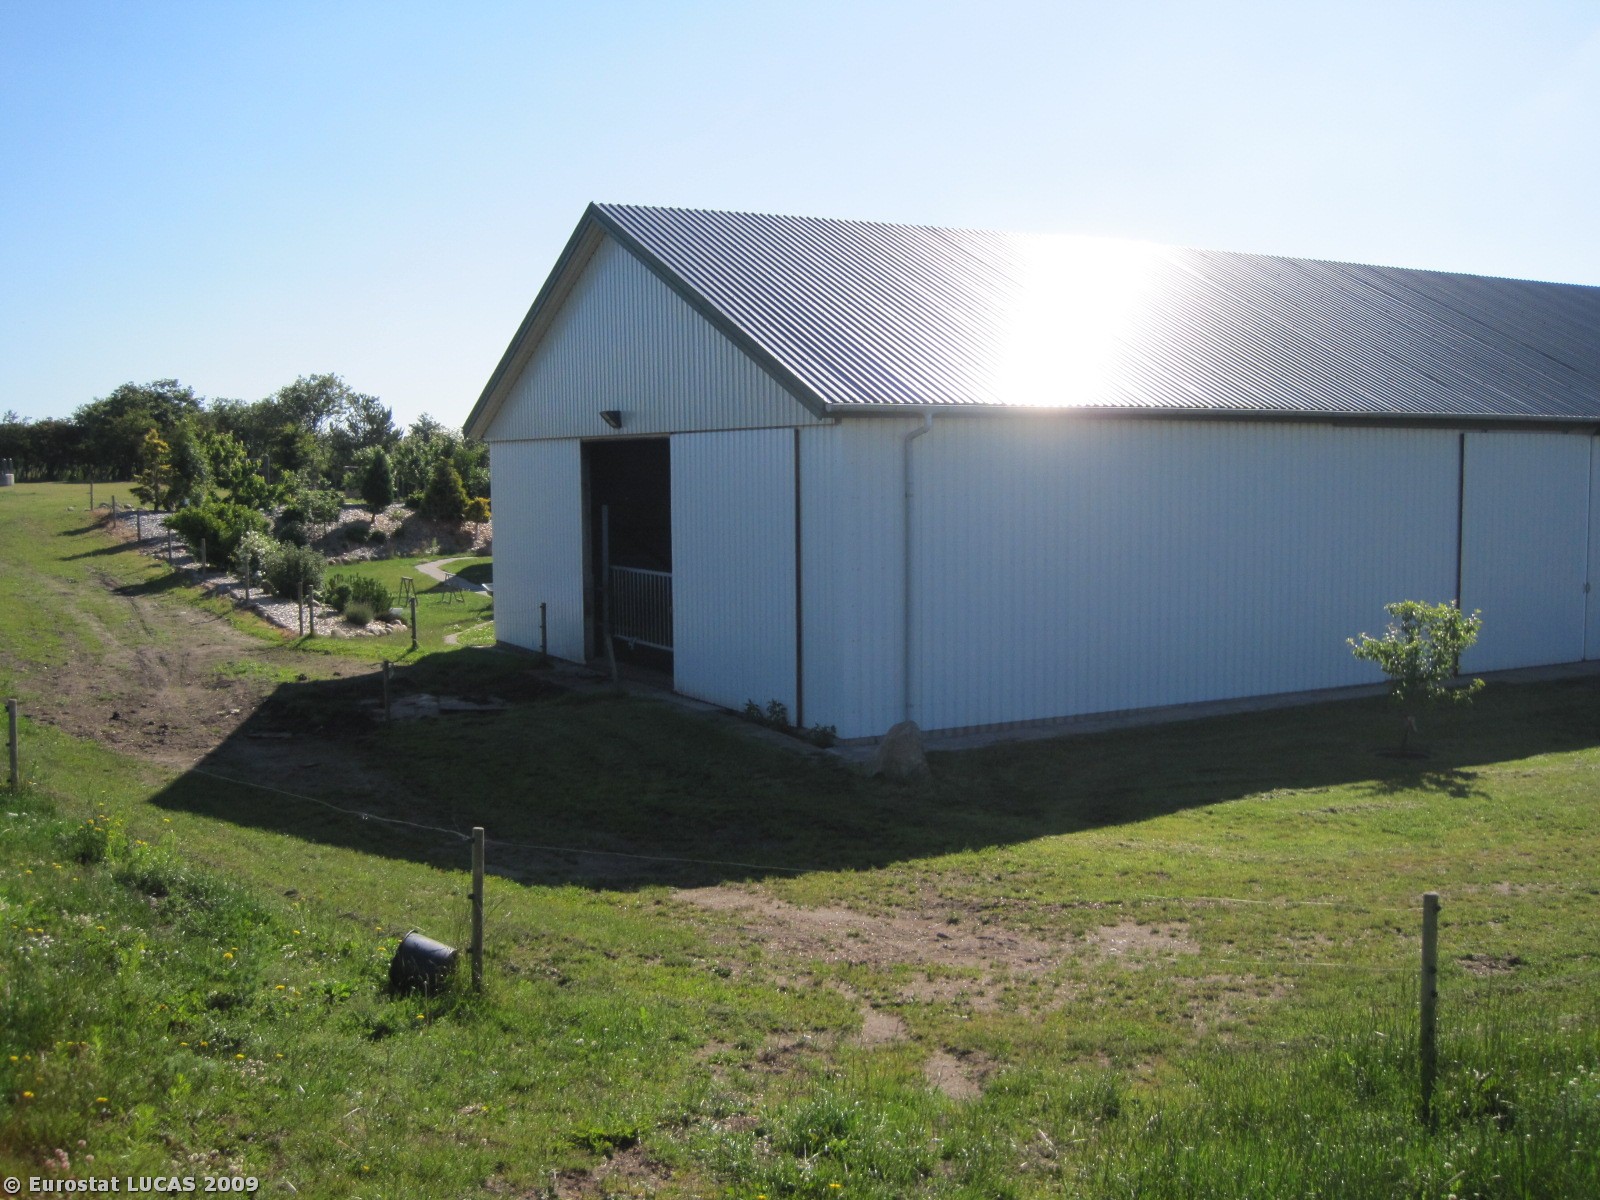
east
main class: Grassland
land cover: Grassland without tree/shrub cover
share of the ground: > 75 %
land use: Agriculture (excluding fallow land and kitchen gardens)
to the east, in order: Grassland without tree/shrub cover; Fences; Grassland without tree/shrub cover; Artificial constructions in urban areas; Grassland without tree/shrub cover; Abandoned hedges; Fences; Grassland without tree/shrub cover; Paved roads, cycling and walking lanes; Grass margins; Shrubland without tree cover; Mixed woodland; Grass margins; Maize; Grass margins; Shrubland without tree cover; Grass margins; Maize
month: June
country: DK
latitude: 56.5448
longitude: 9.2041
